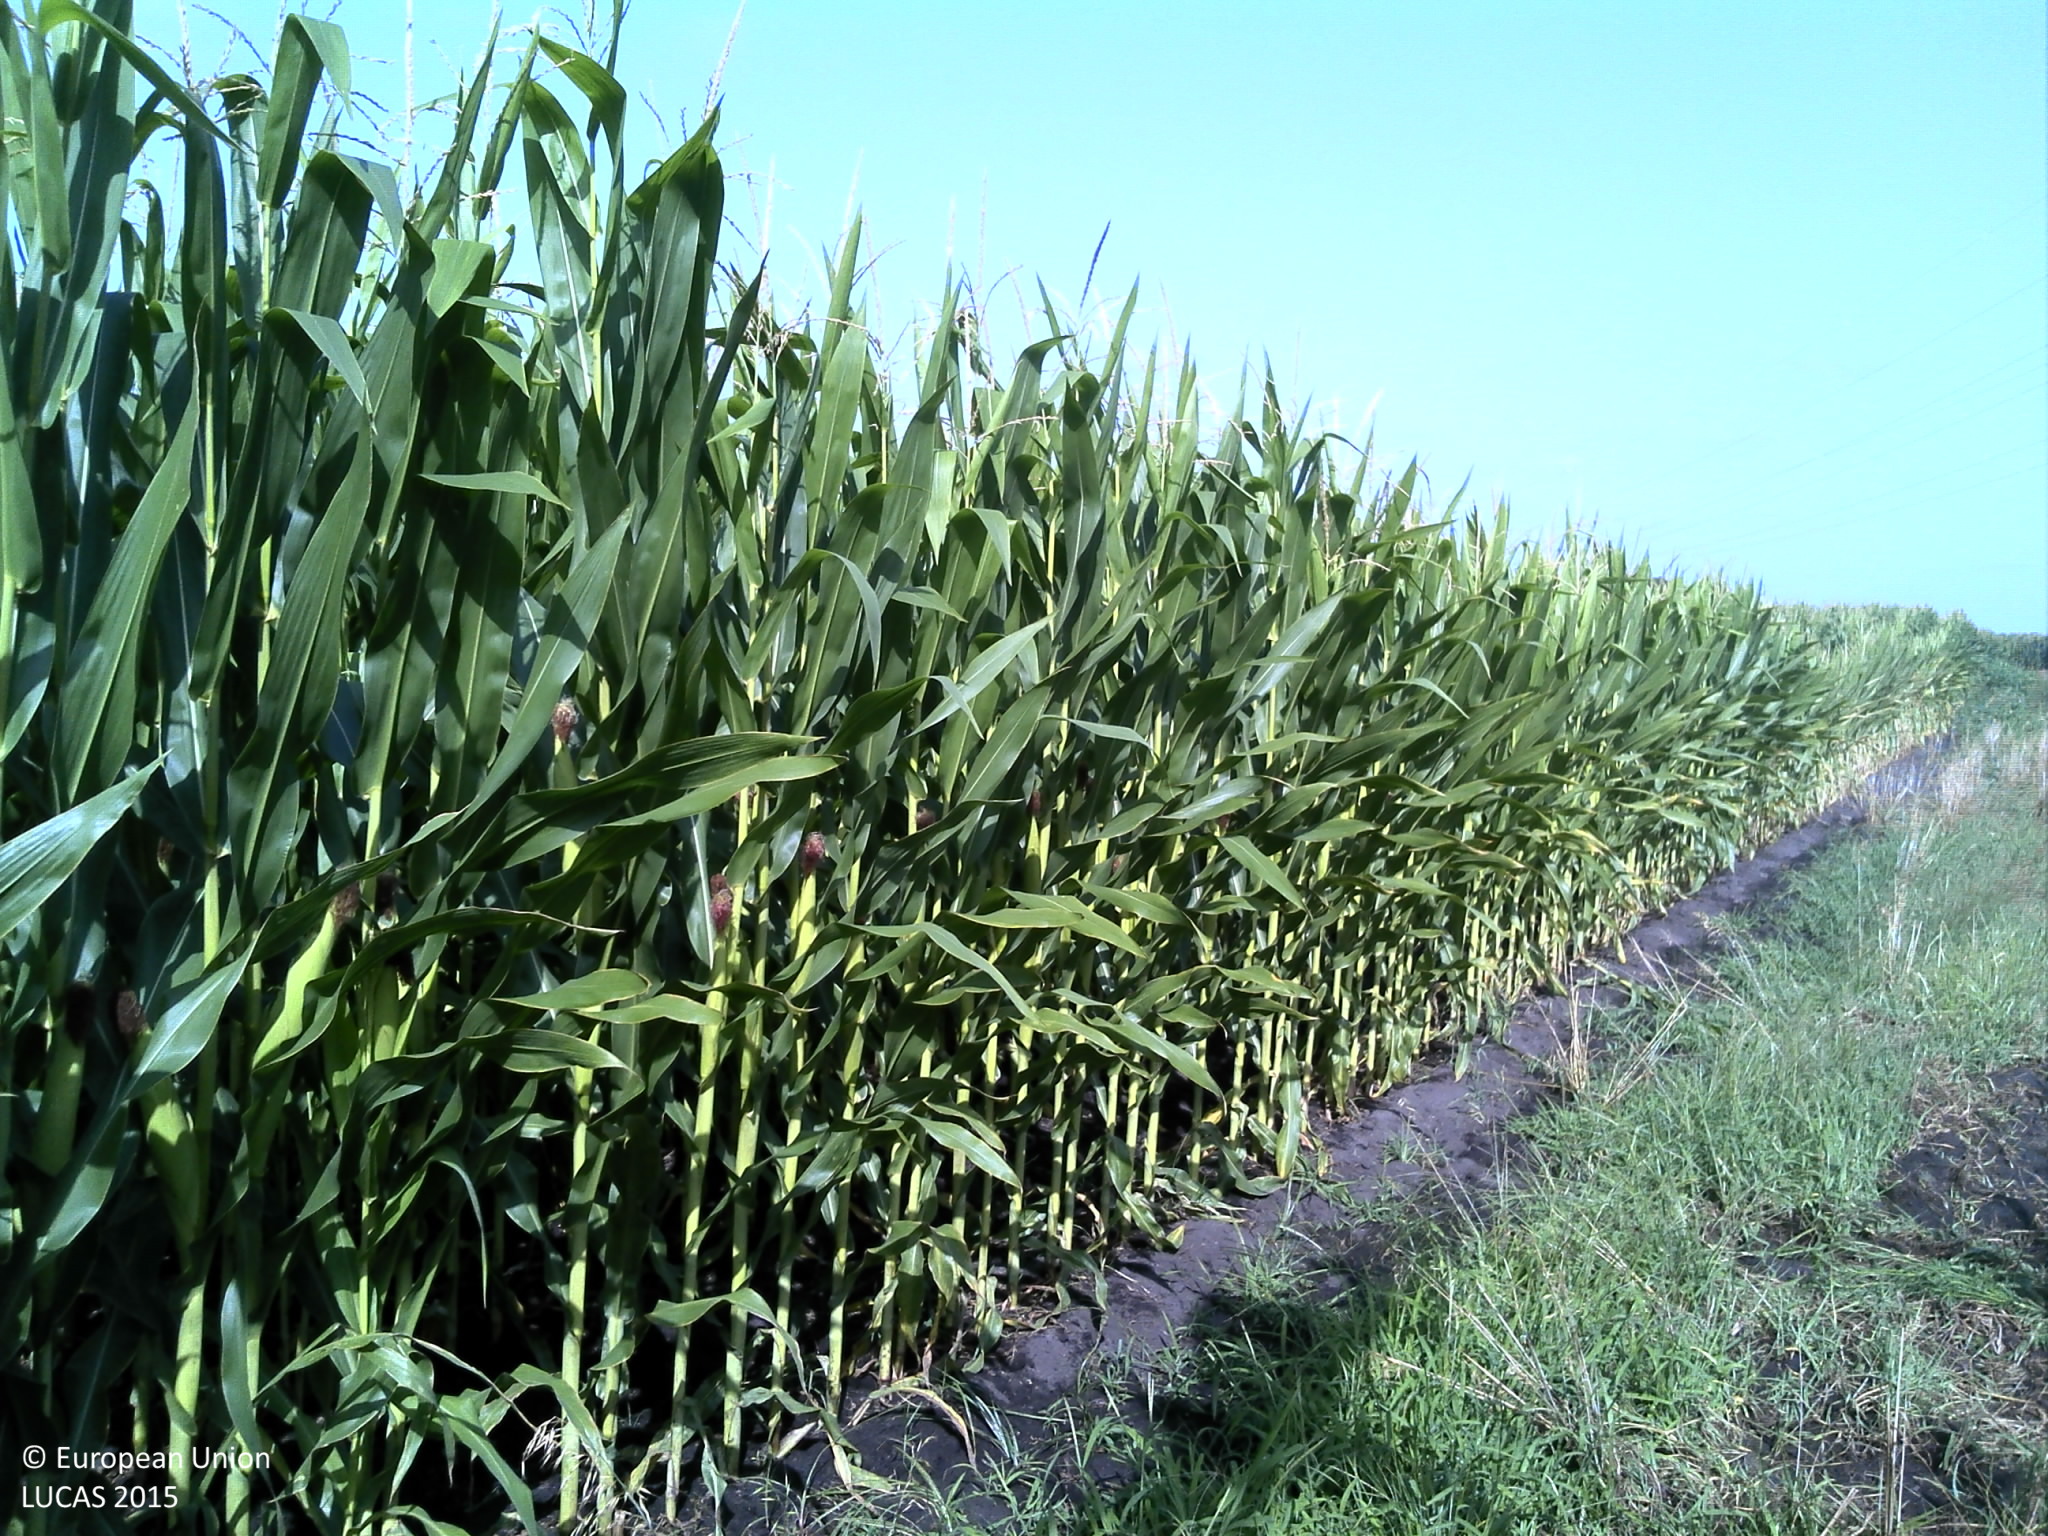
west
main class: Cropland
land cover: Maize
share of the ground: > 75 %
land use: Agriculture (excluding fallow land and kitchen gardens)
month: July
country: FR
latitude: 44.5993
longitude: -0.6635
